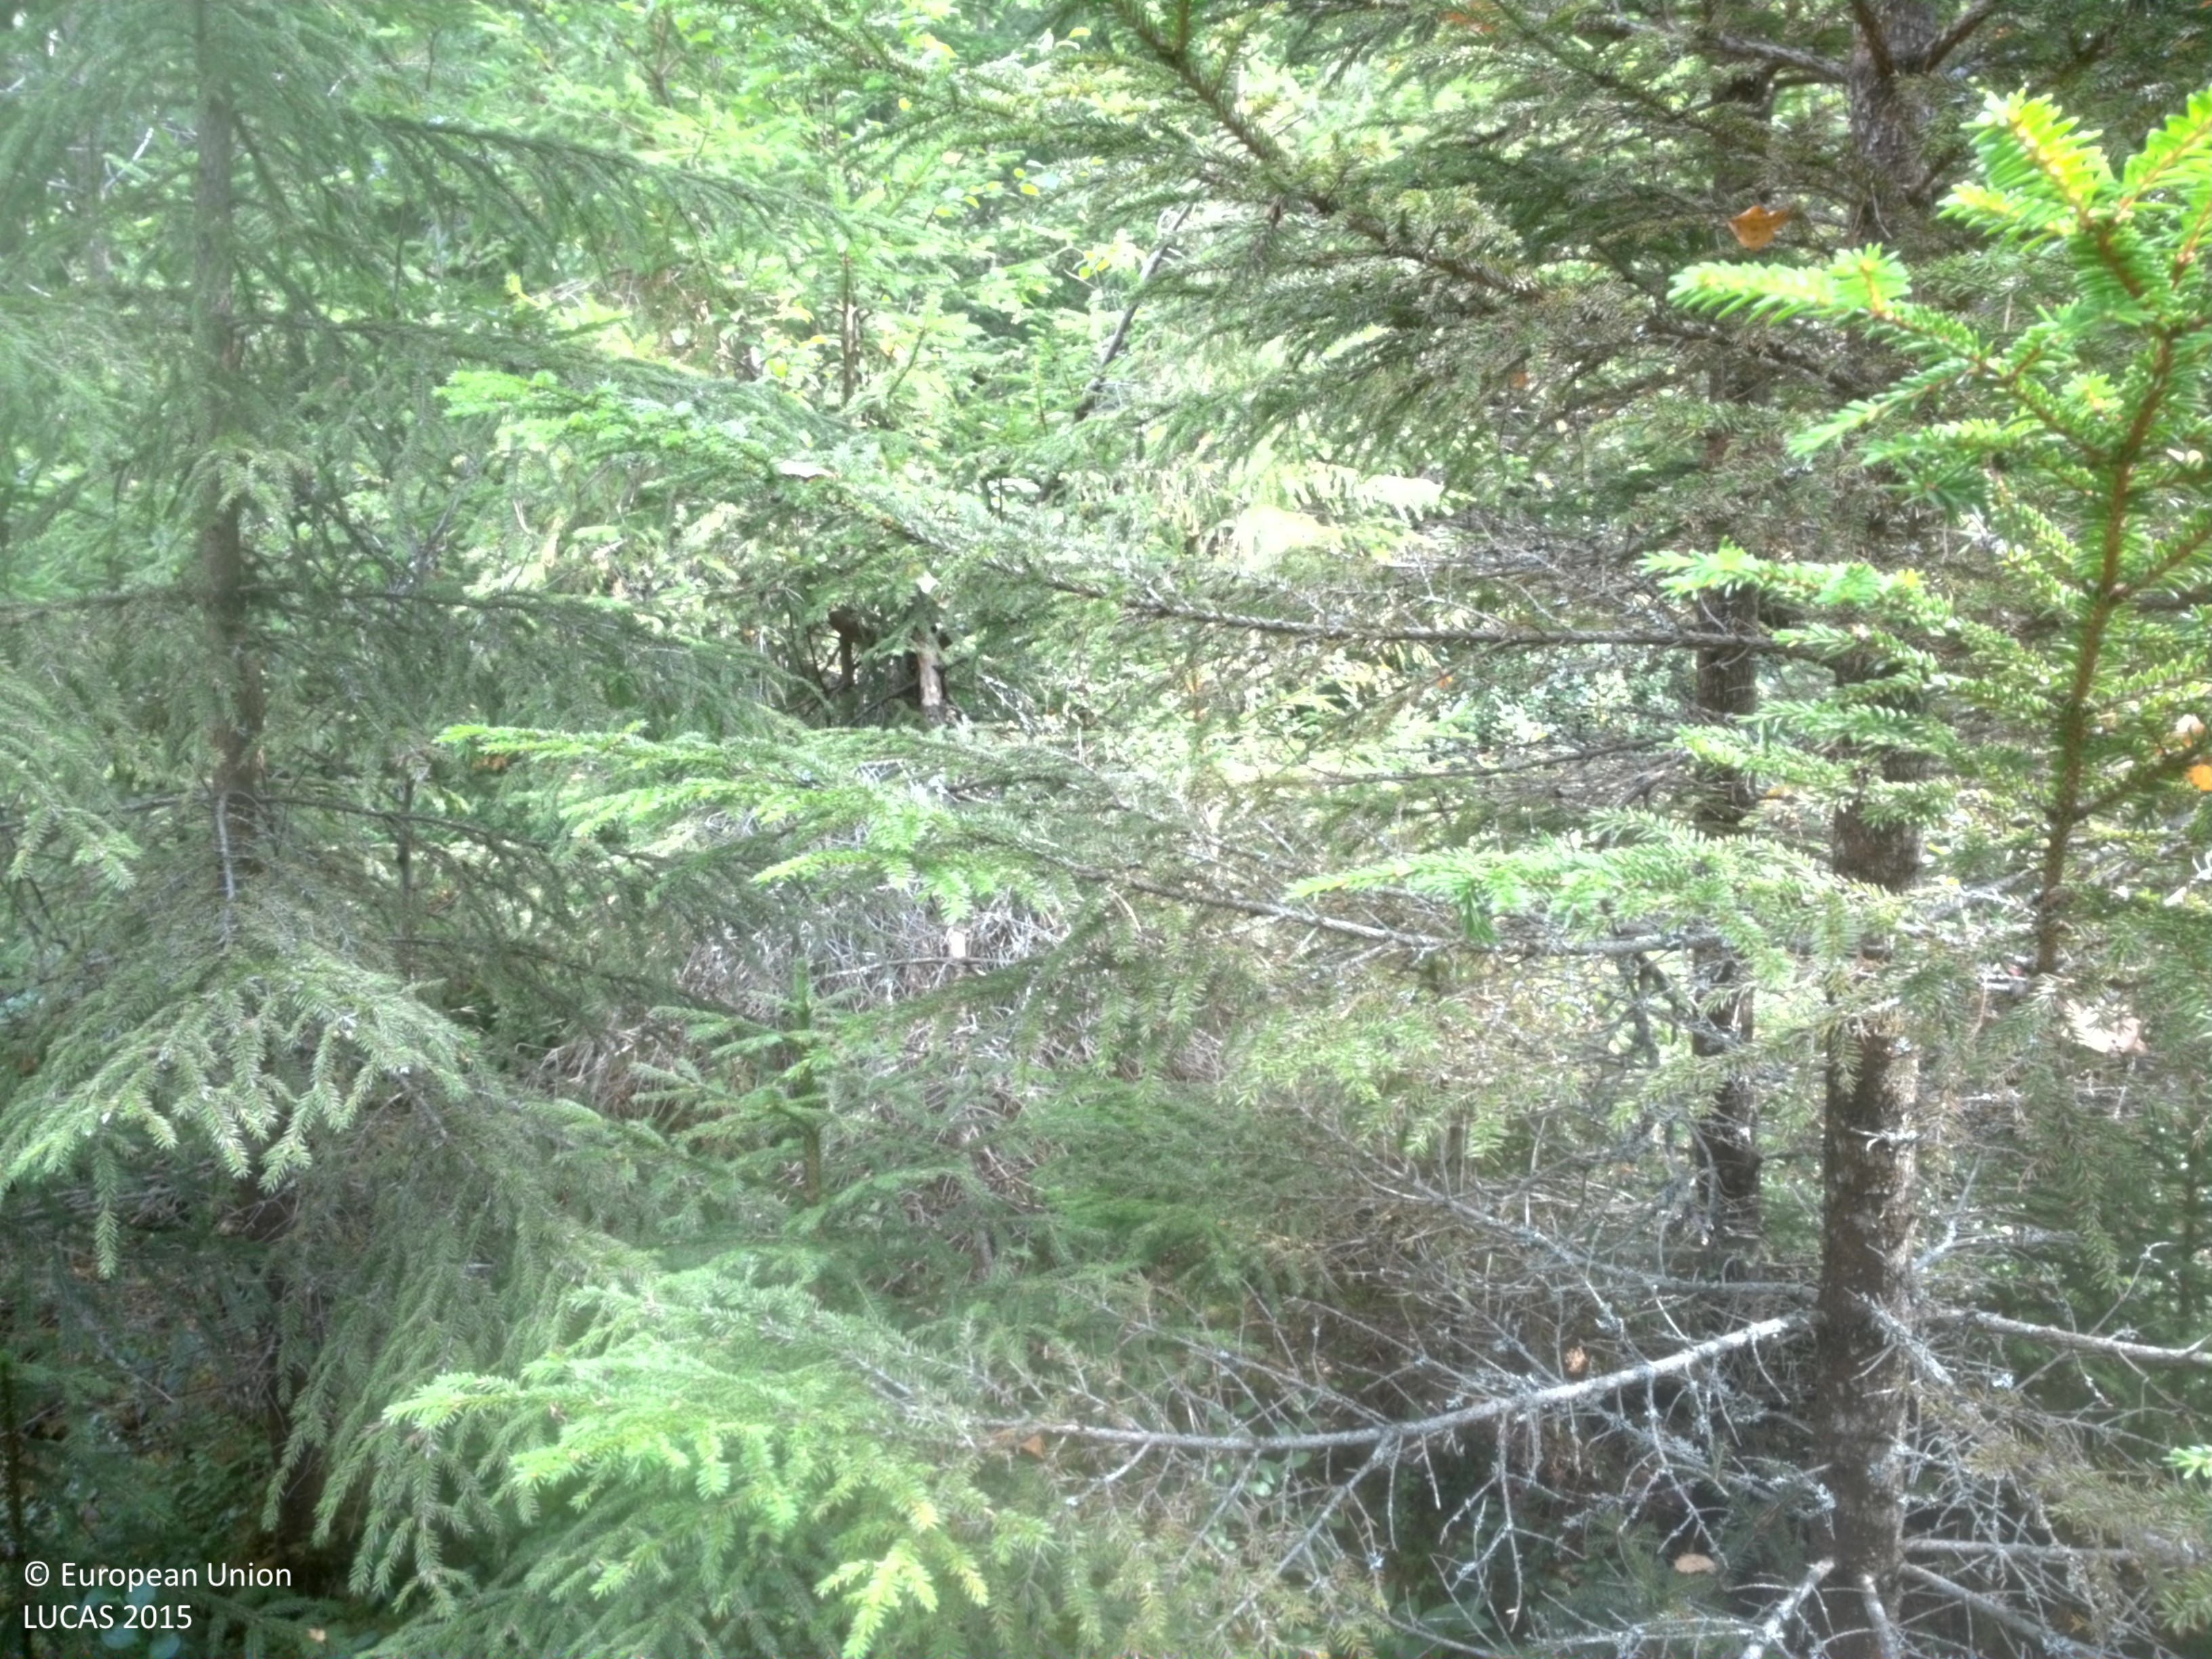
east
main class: Woodland
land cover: Spruce dominated mixed woodland
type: boreal forest
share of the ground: > 75 %
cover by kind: coniferous forest trees 50 %, broadleaved forest trees 25 %, shrubs 10 %, herbaceous plants 10 %, lichens and mosses 5 %
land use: Forestry
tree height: > 5 m
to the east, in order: Spruce dominated mixed woodland; Pine dominated coniferous woodland; Spruce dominated mixed woodland; Shrubland with sparse tree cover
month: August
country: SE
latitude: 59.7420
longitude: 15.6660
